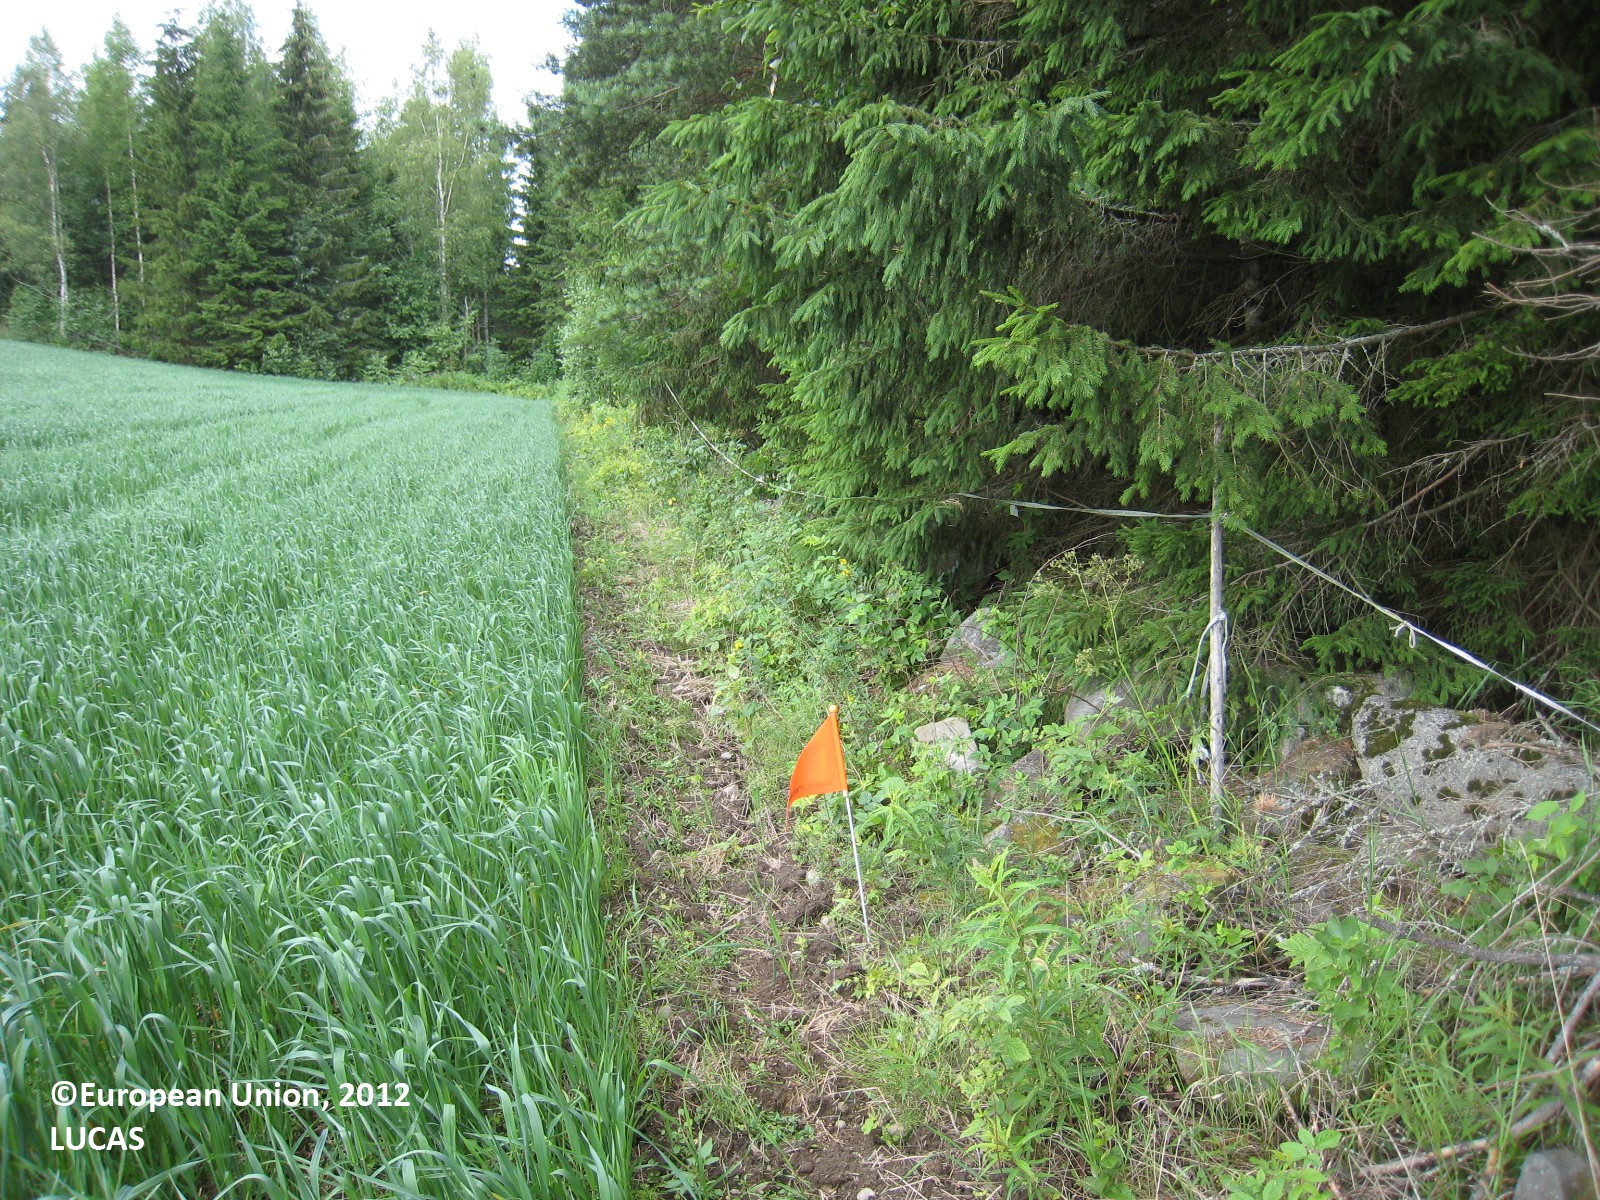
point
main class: Woodland
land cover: Other mixed woodland
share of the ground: > 75 %
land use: Semi-natural and natural areas not in use
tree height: > 5 m
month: July
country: FI
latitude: 61.8677
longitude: 27.0614
